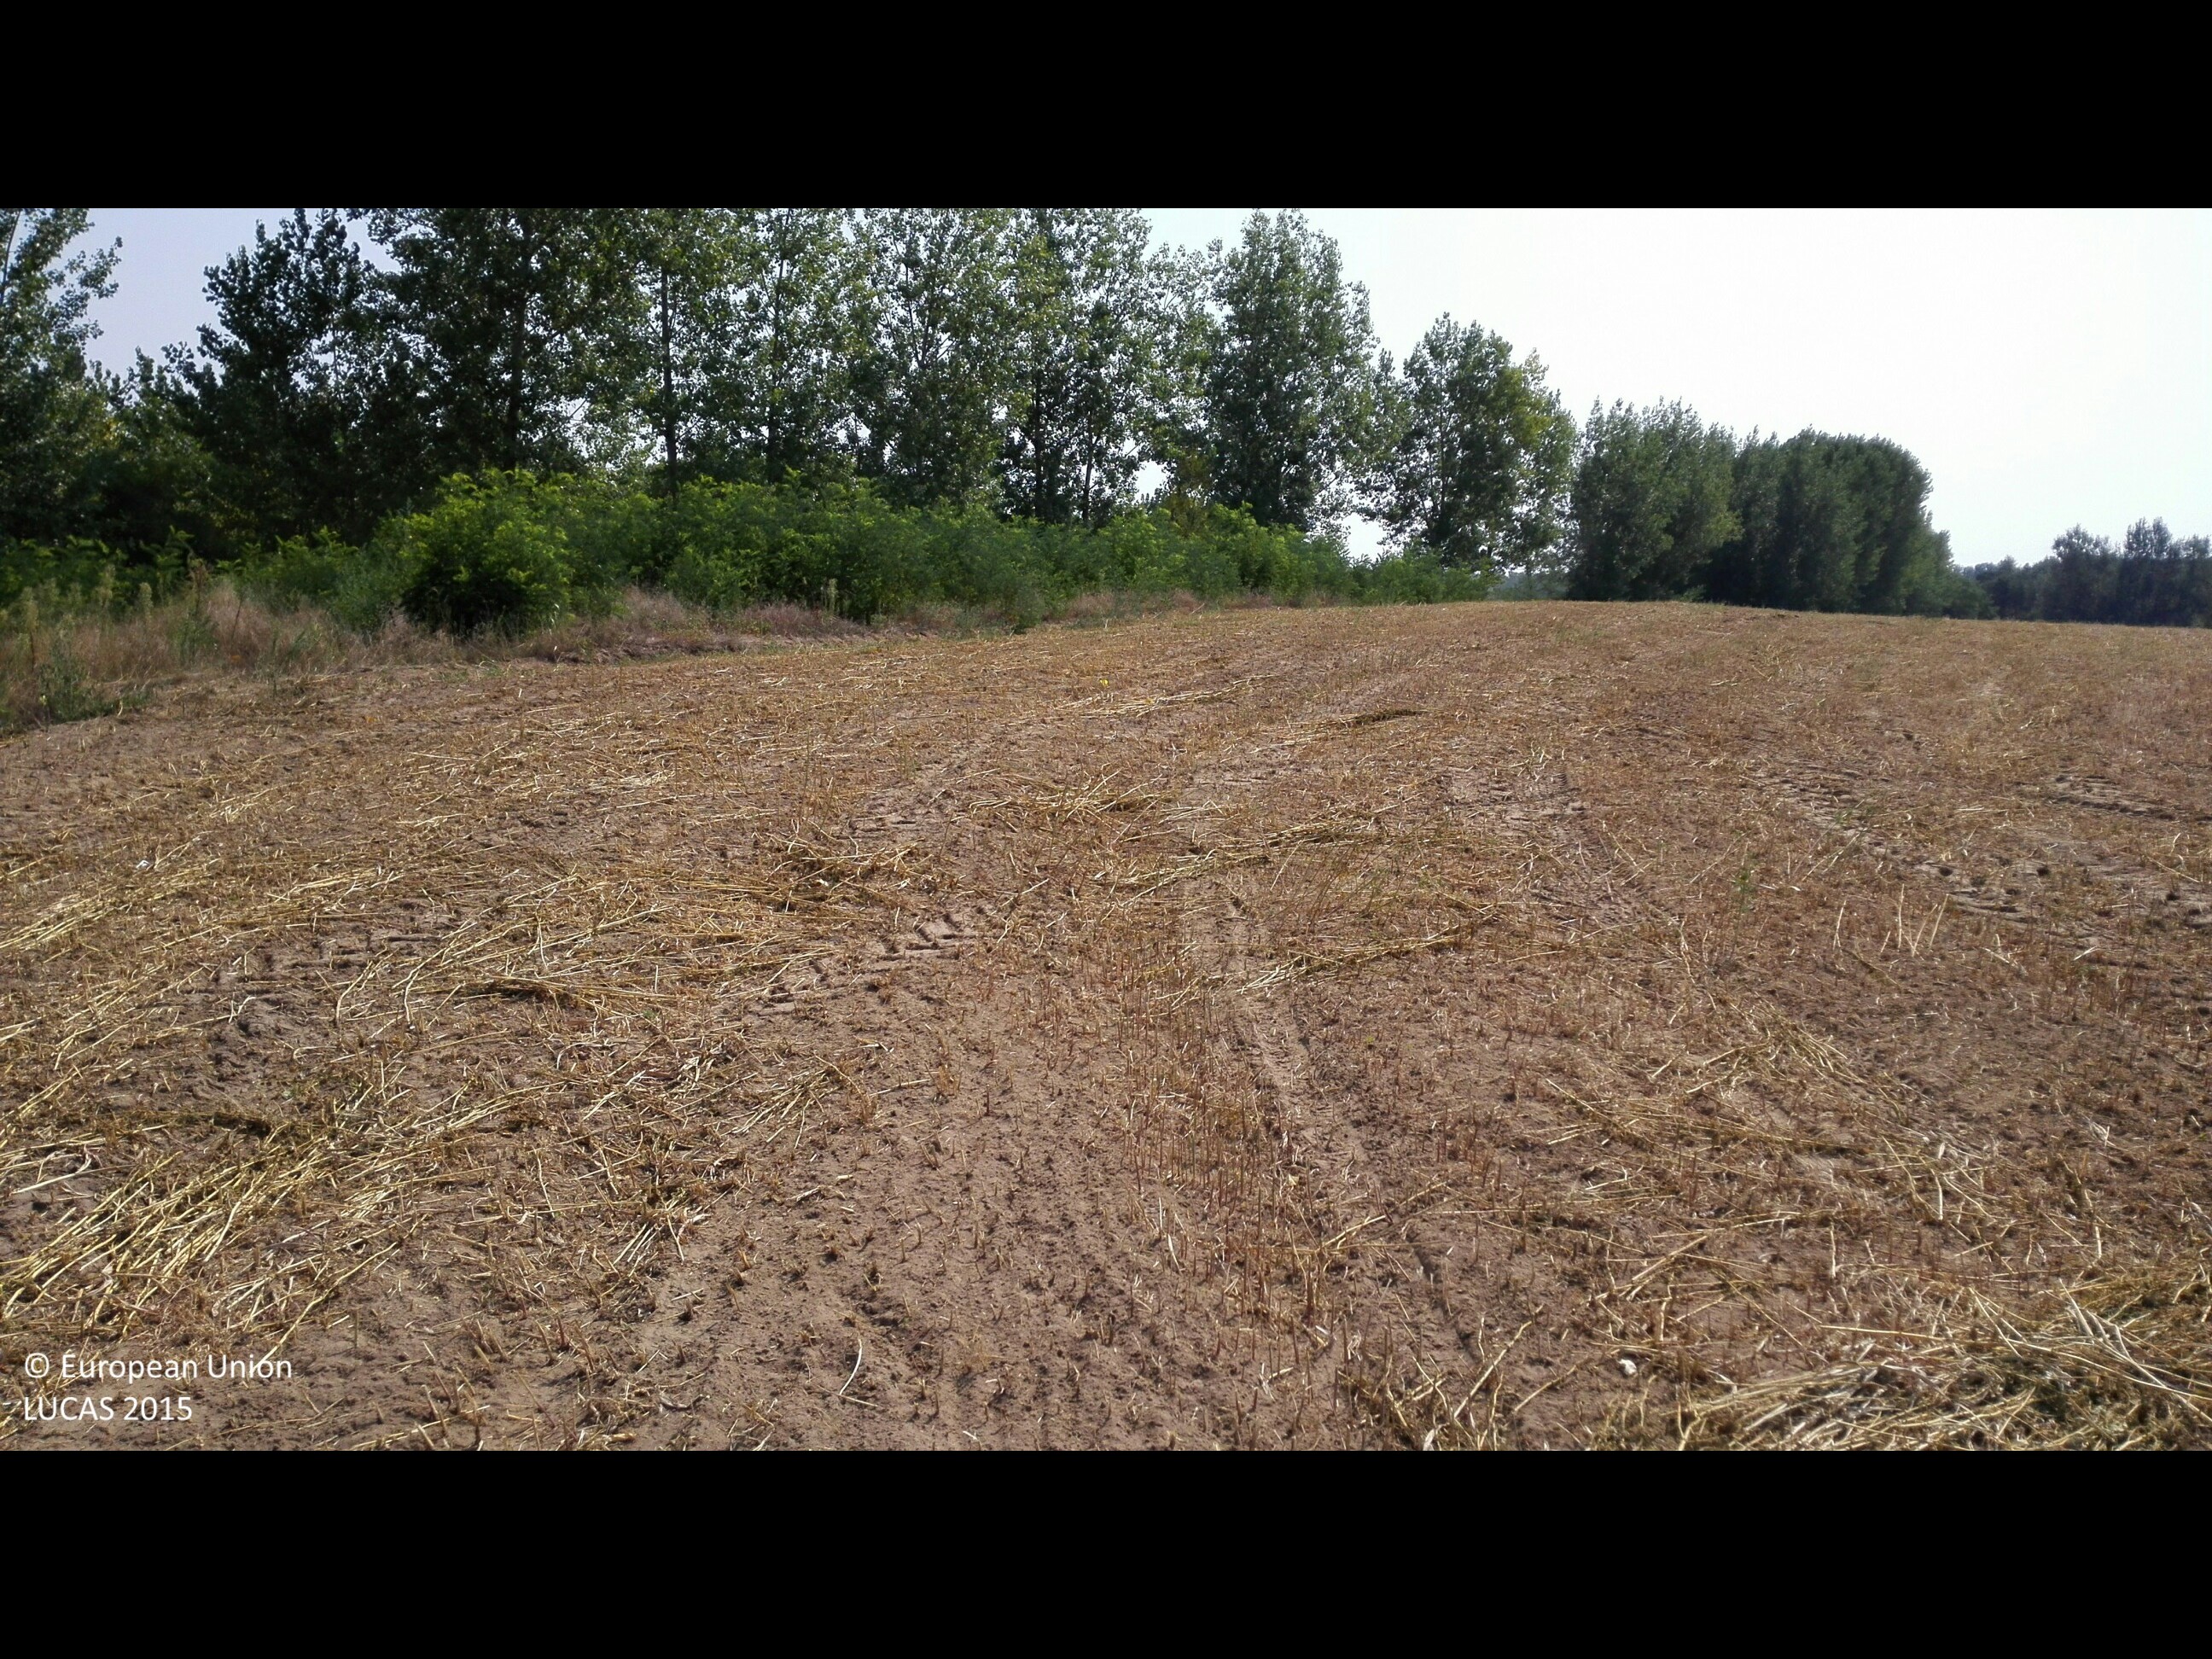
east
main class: Cropland
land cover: Rape and turnip rape
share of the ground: 10 - 25 %
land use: Agriculture (excluding fallow land and kitchen gardens)
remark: Harvested field
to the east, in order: Rape and turnip rape; Spontaneously vegetated surfaces; Inland fresh running water; Lines of trees; Paved roads, cycling and walking lanes; Grassland without tree/shrub cover; Fences; Broadleaved woodland; Tracks; Artificial constructions in urban areas; Other fruit trees and berries
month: August
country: HU
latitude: 47.4757
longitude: 21.6552
